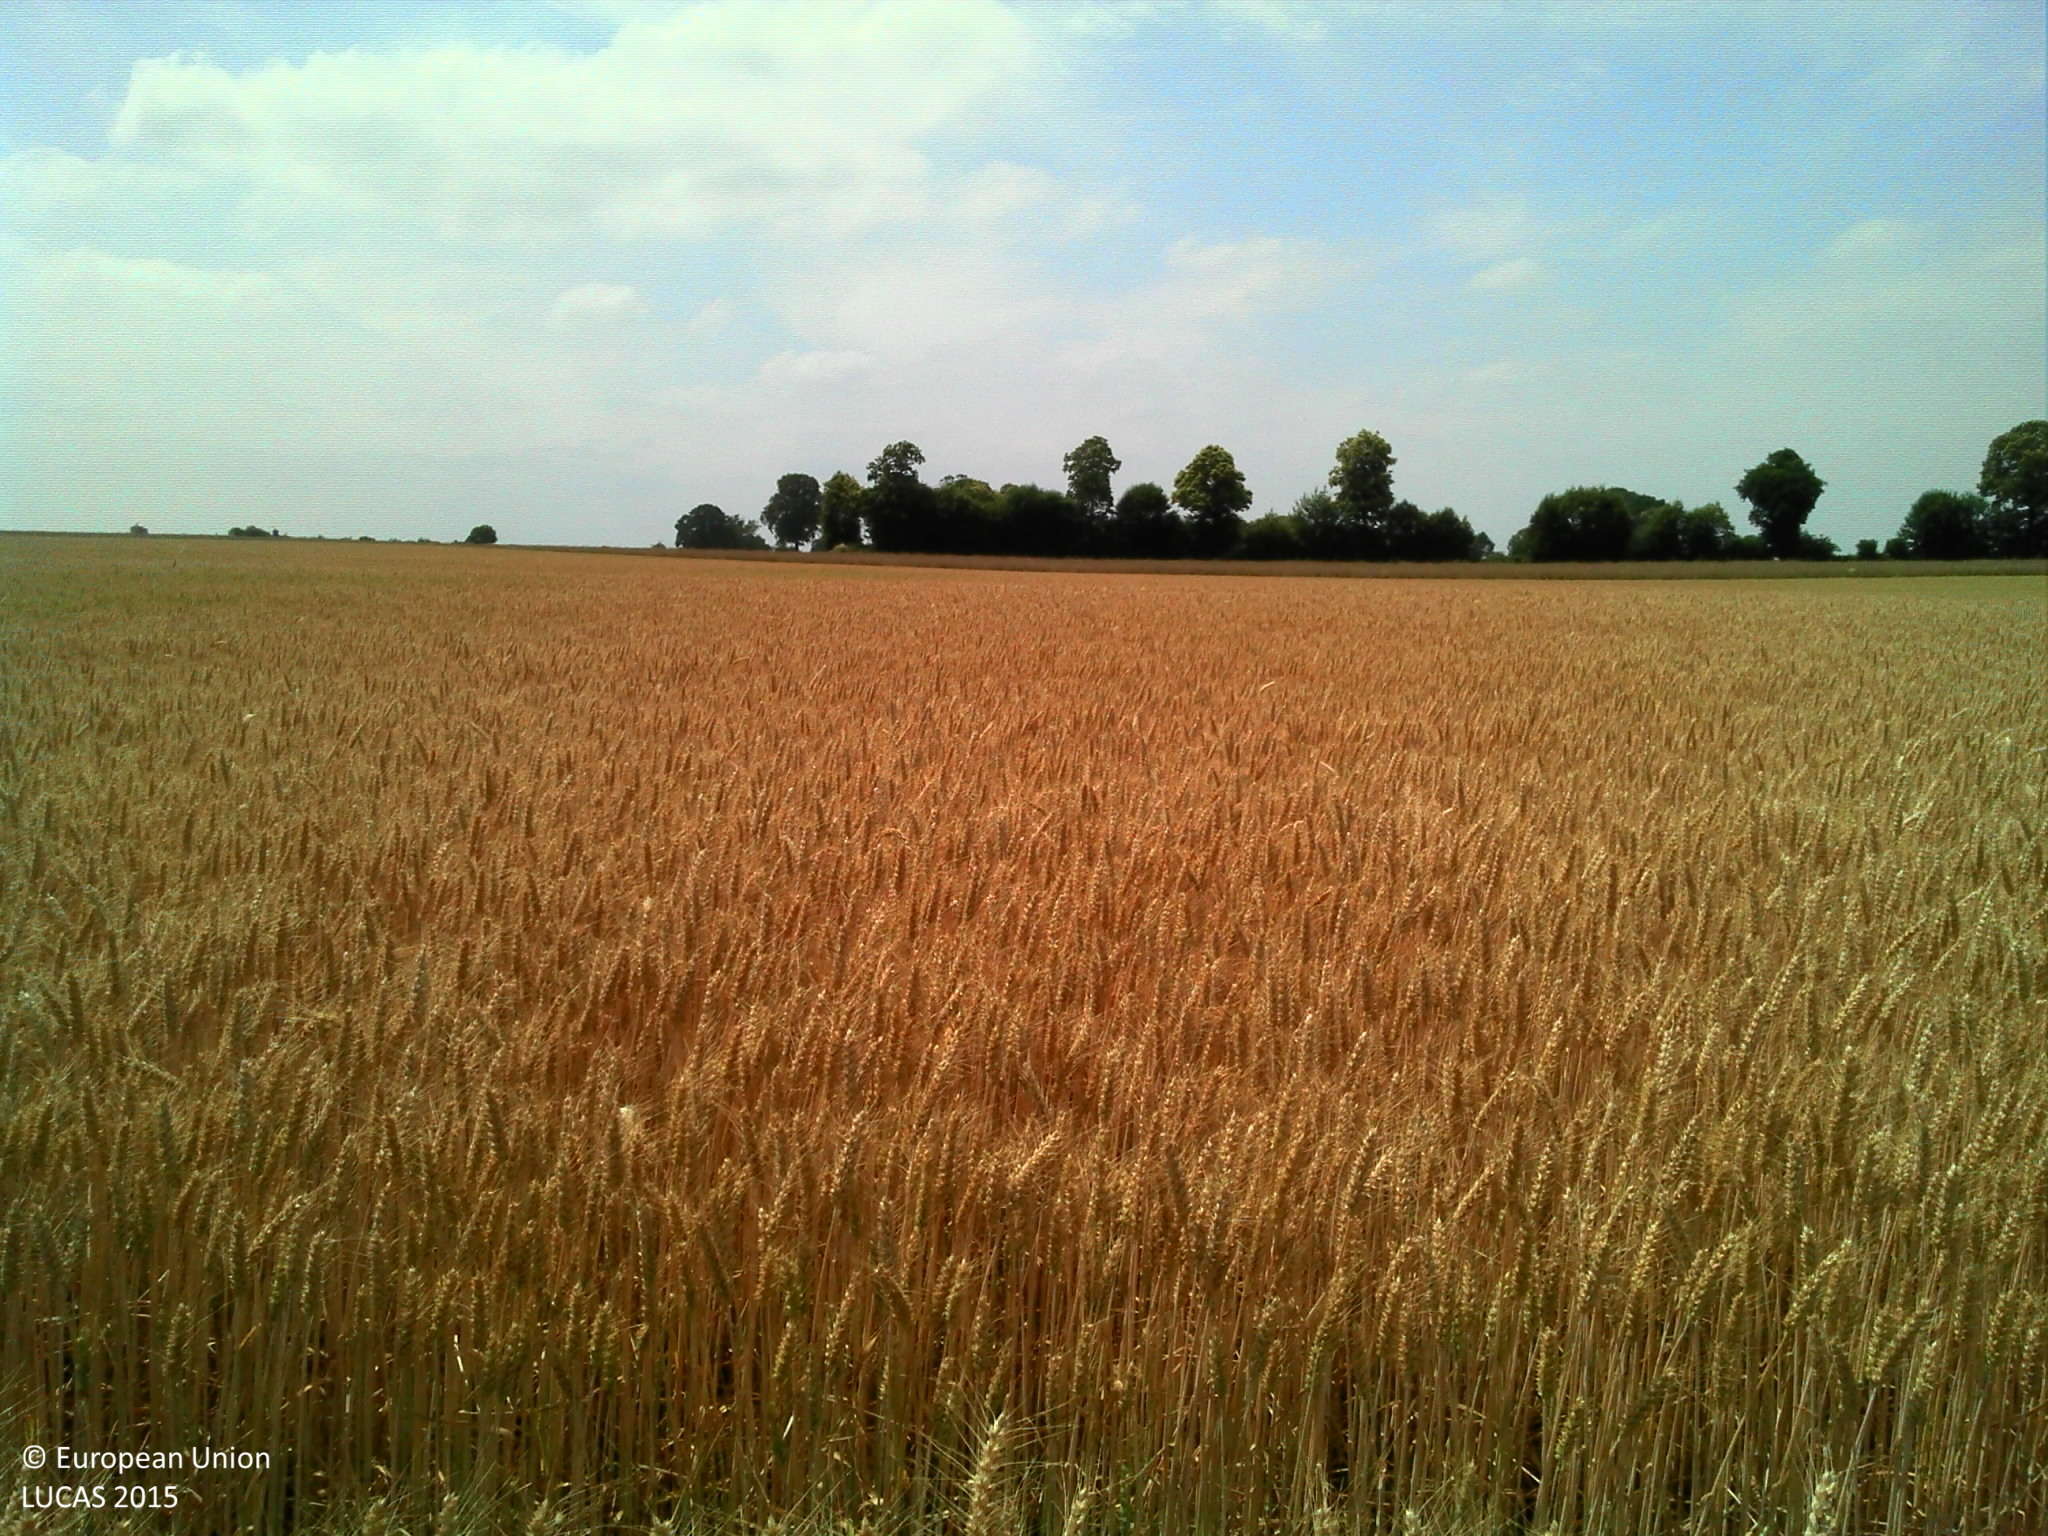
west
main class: Cropland
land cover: Durum wheat
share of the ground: > 75 %
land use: Agriculture (excluding fallow land and kitchen gardens)
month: July
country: FR
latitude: 47.9805
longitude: -1.1742
